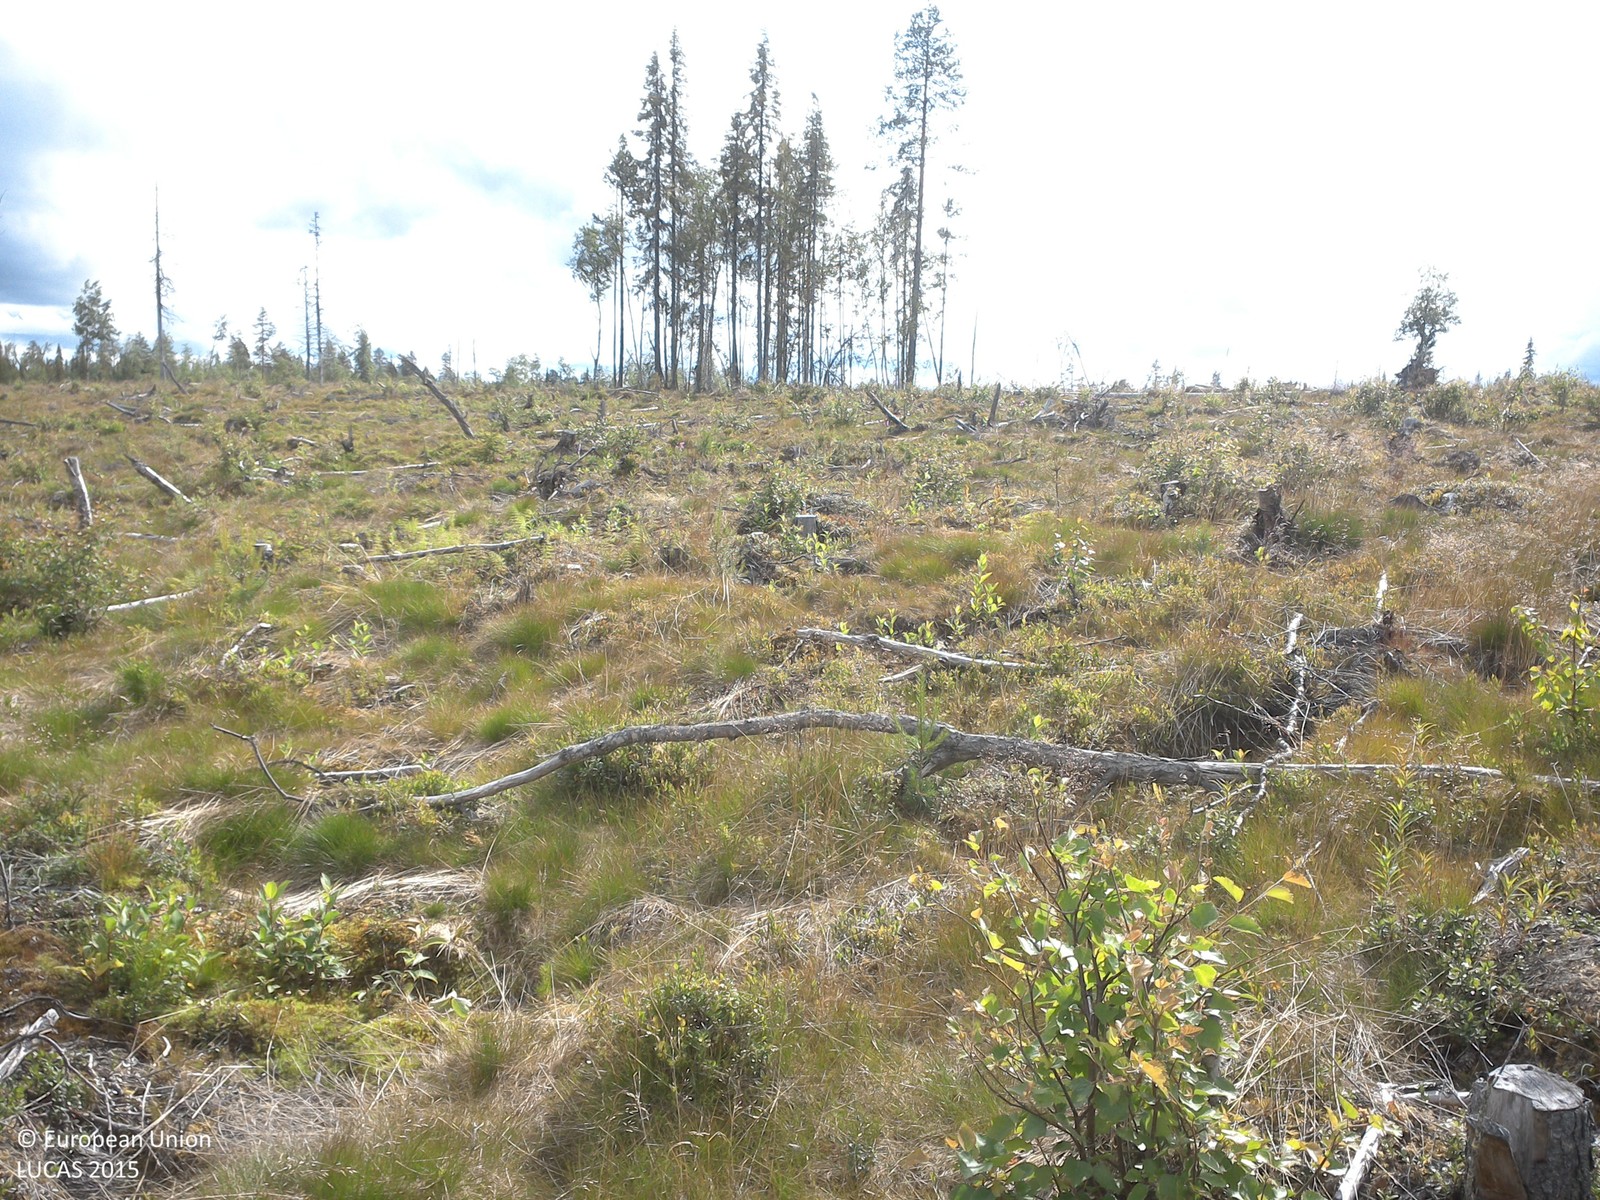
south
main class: Shrubland
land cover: Shrubland with sparse tree cover
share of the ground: 10 - 25 %
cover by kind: herbaceous plants 75 %, shrubs 10 %, unconsolidated bare surface 10 %, broadleaved forest trees 5 %
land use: Forestry
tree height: < 5 m
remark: Clear cut
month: July
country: SE
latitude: 67.5009
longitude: 22.2495
